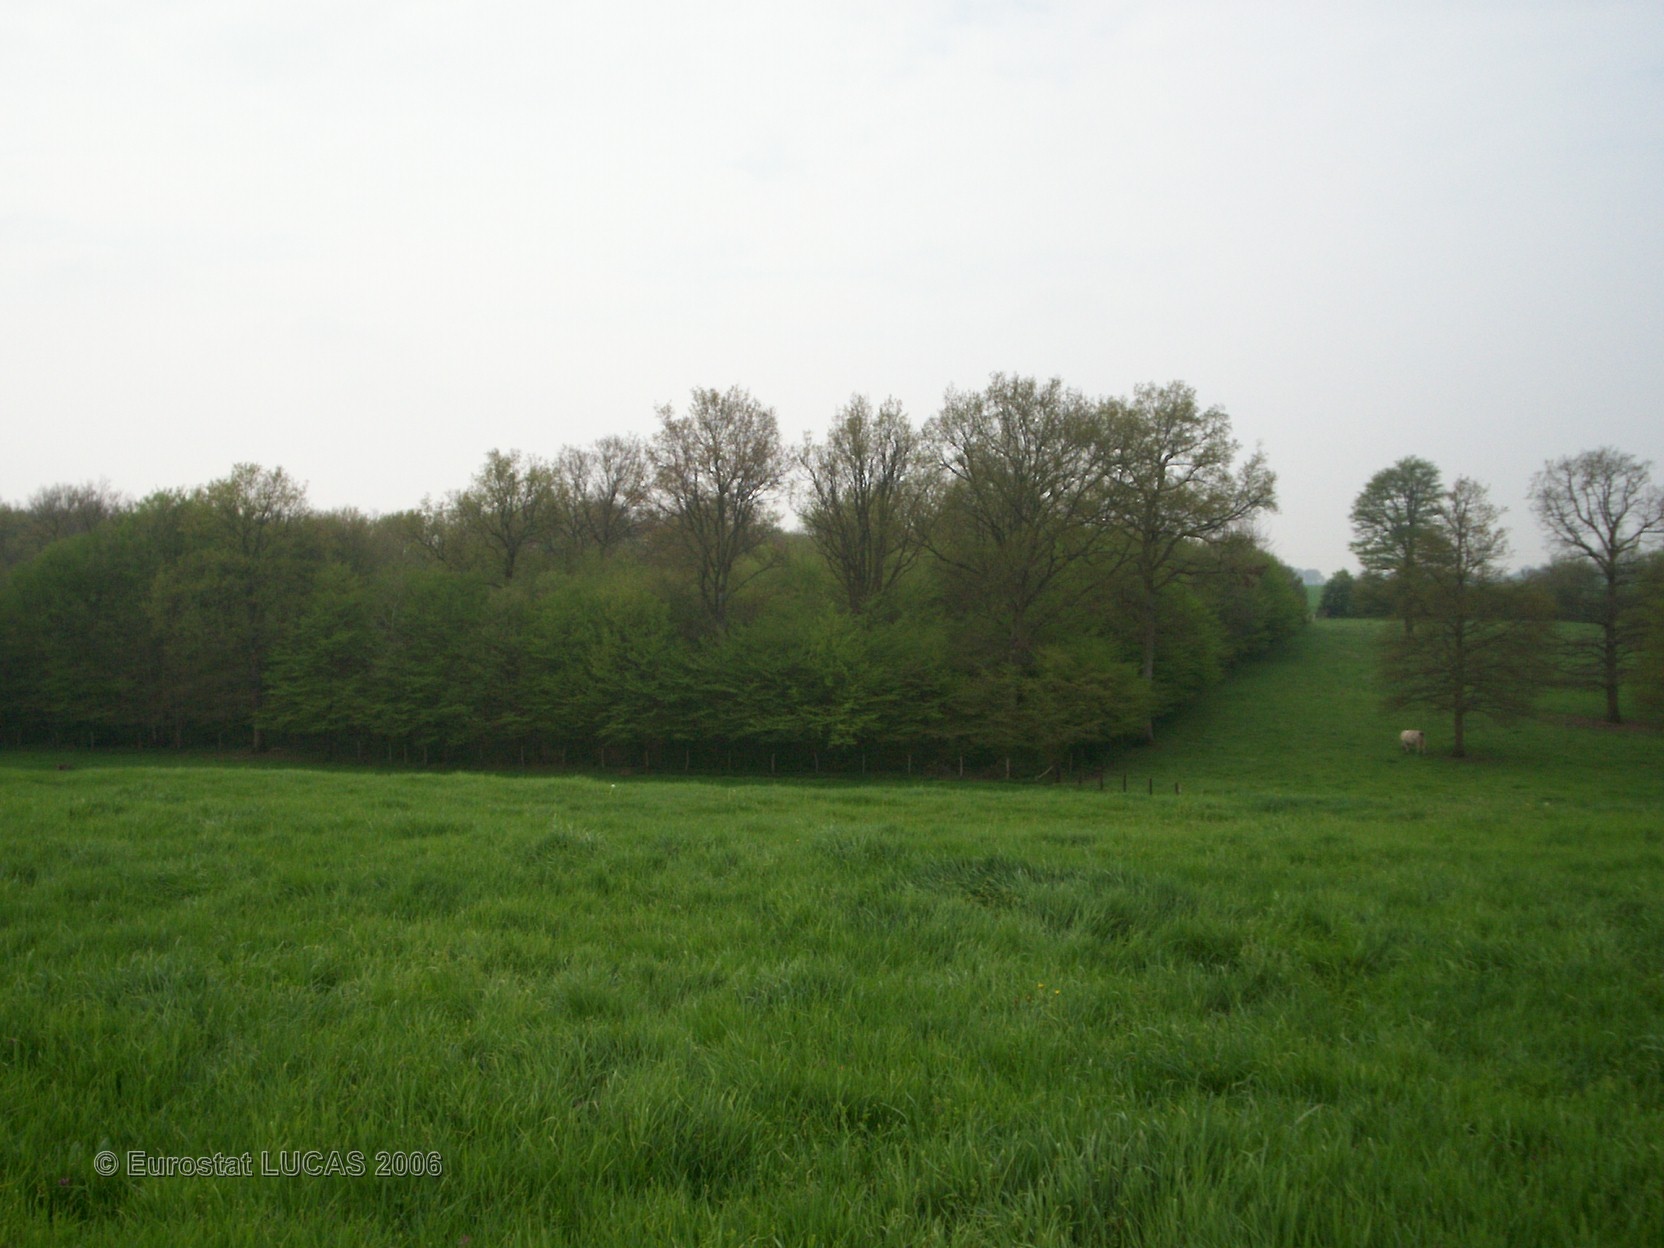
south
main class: Grassland
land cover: Grassland without tree/shrub cover
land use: Agriculture (excluding fallow land and kitchen gardens)
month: April
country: FR
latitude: 48.0109
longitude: 2.8741
